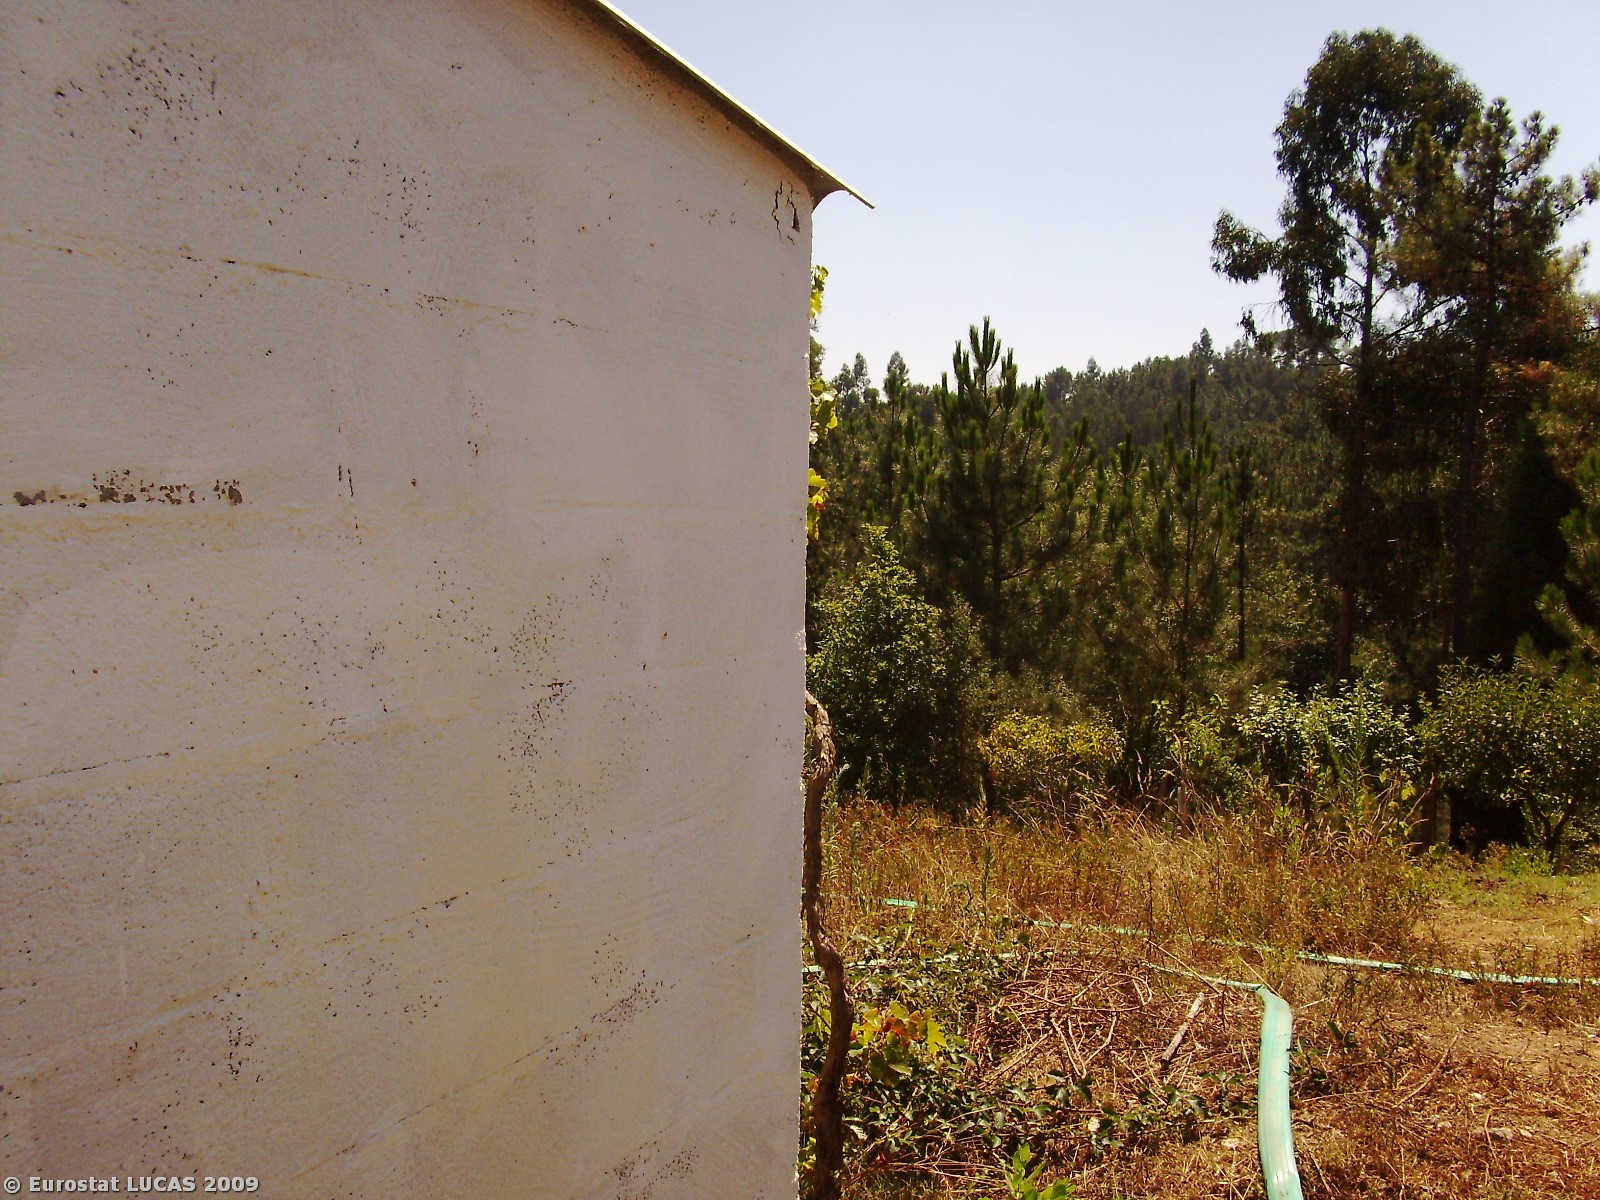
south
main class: Grassland
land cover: Spontaneously vegetated surfaces
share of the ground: > 75 %
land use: Fallow land
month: August
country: PT
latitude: 40.1894
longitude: -8.2248
